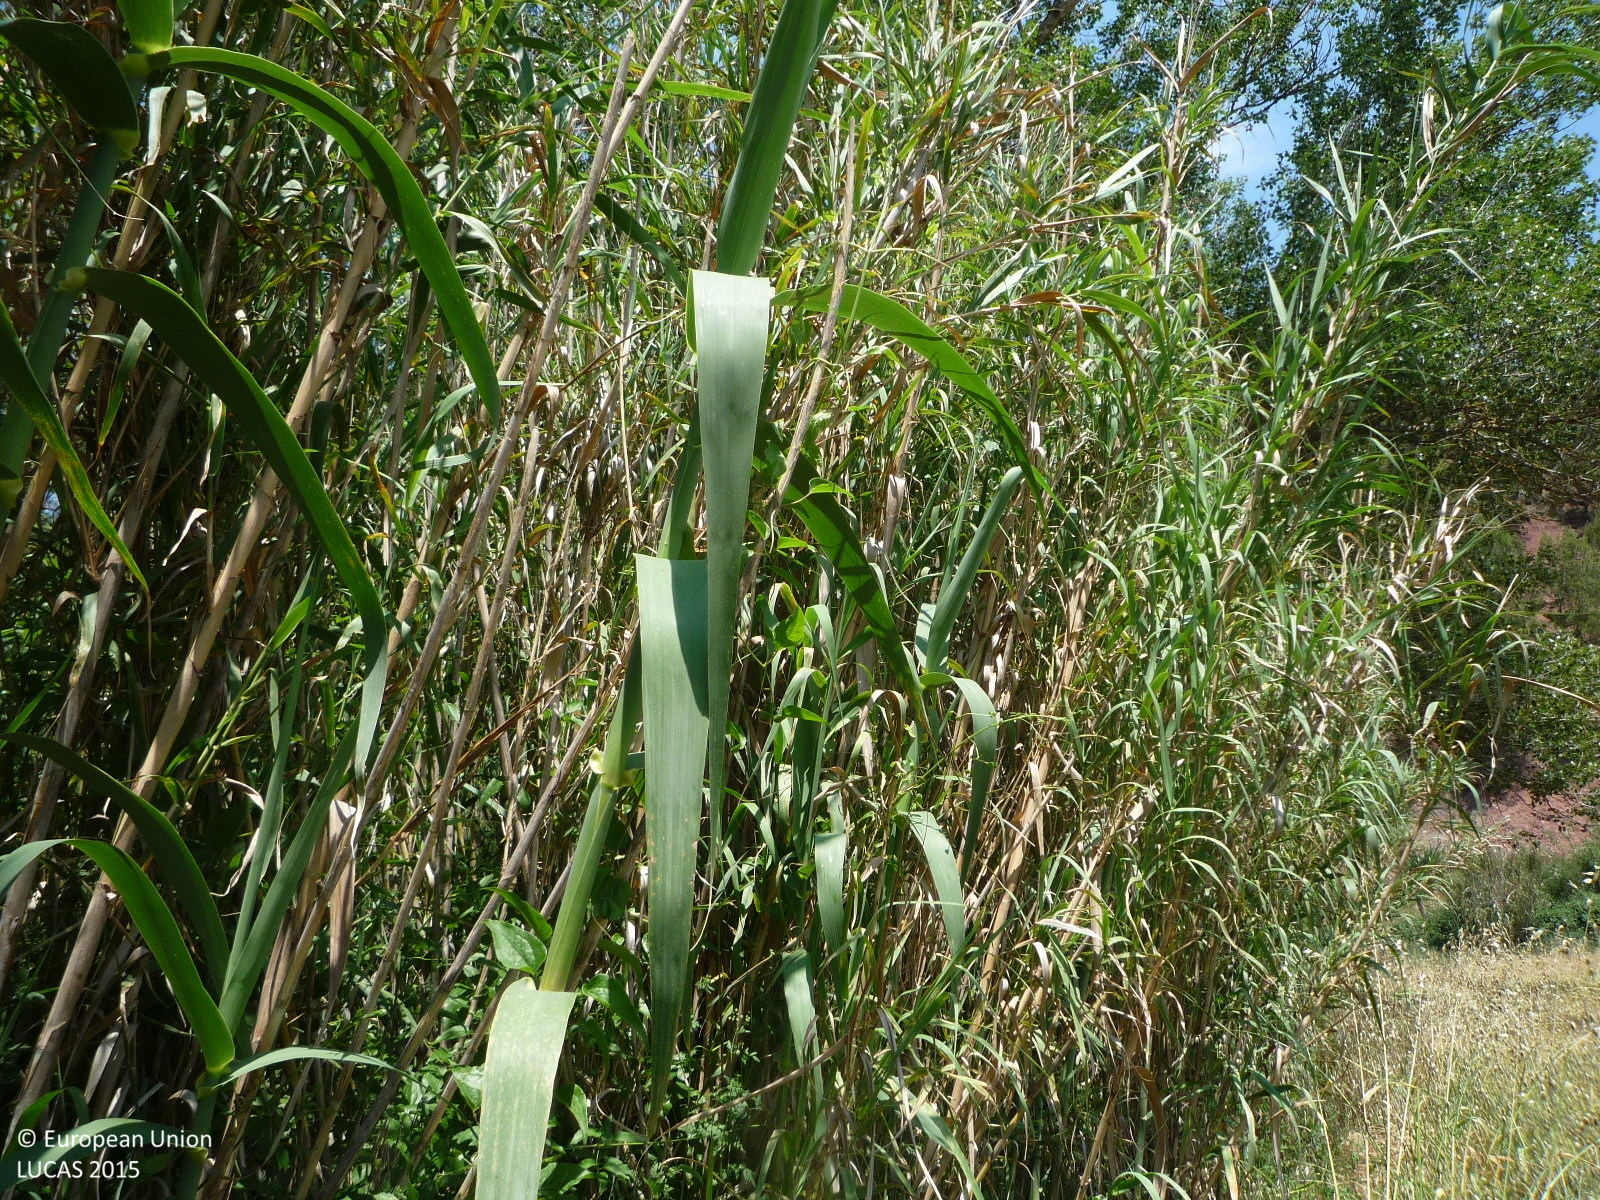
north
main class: Shrubland
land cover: Shrubland with sparse tree cover
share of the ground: > 75 %
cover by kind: shrubs 95 %, broadleaved forest trees 5 %
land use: Semi-natural and natural areas not in use
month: June
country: ES
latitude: 41.8080
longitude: 1.9625
